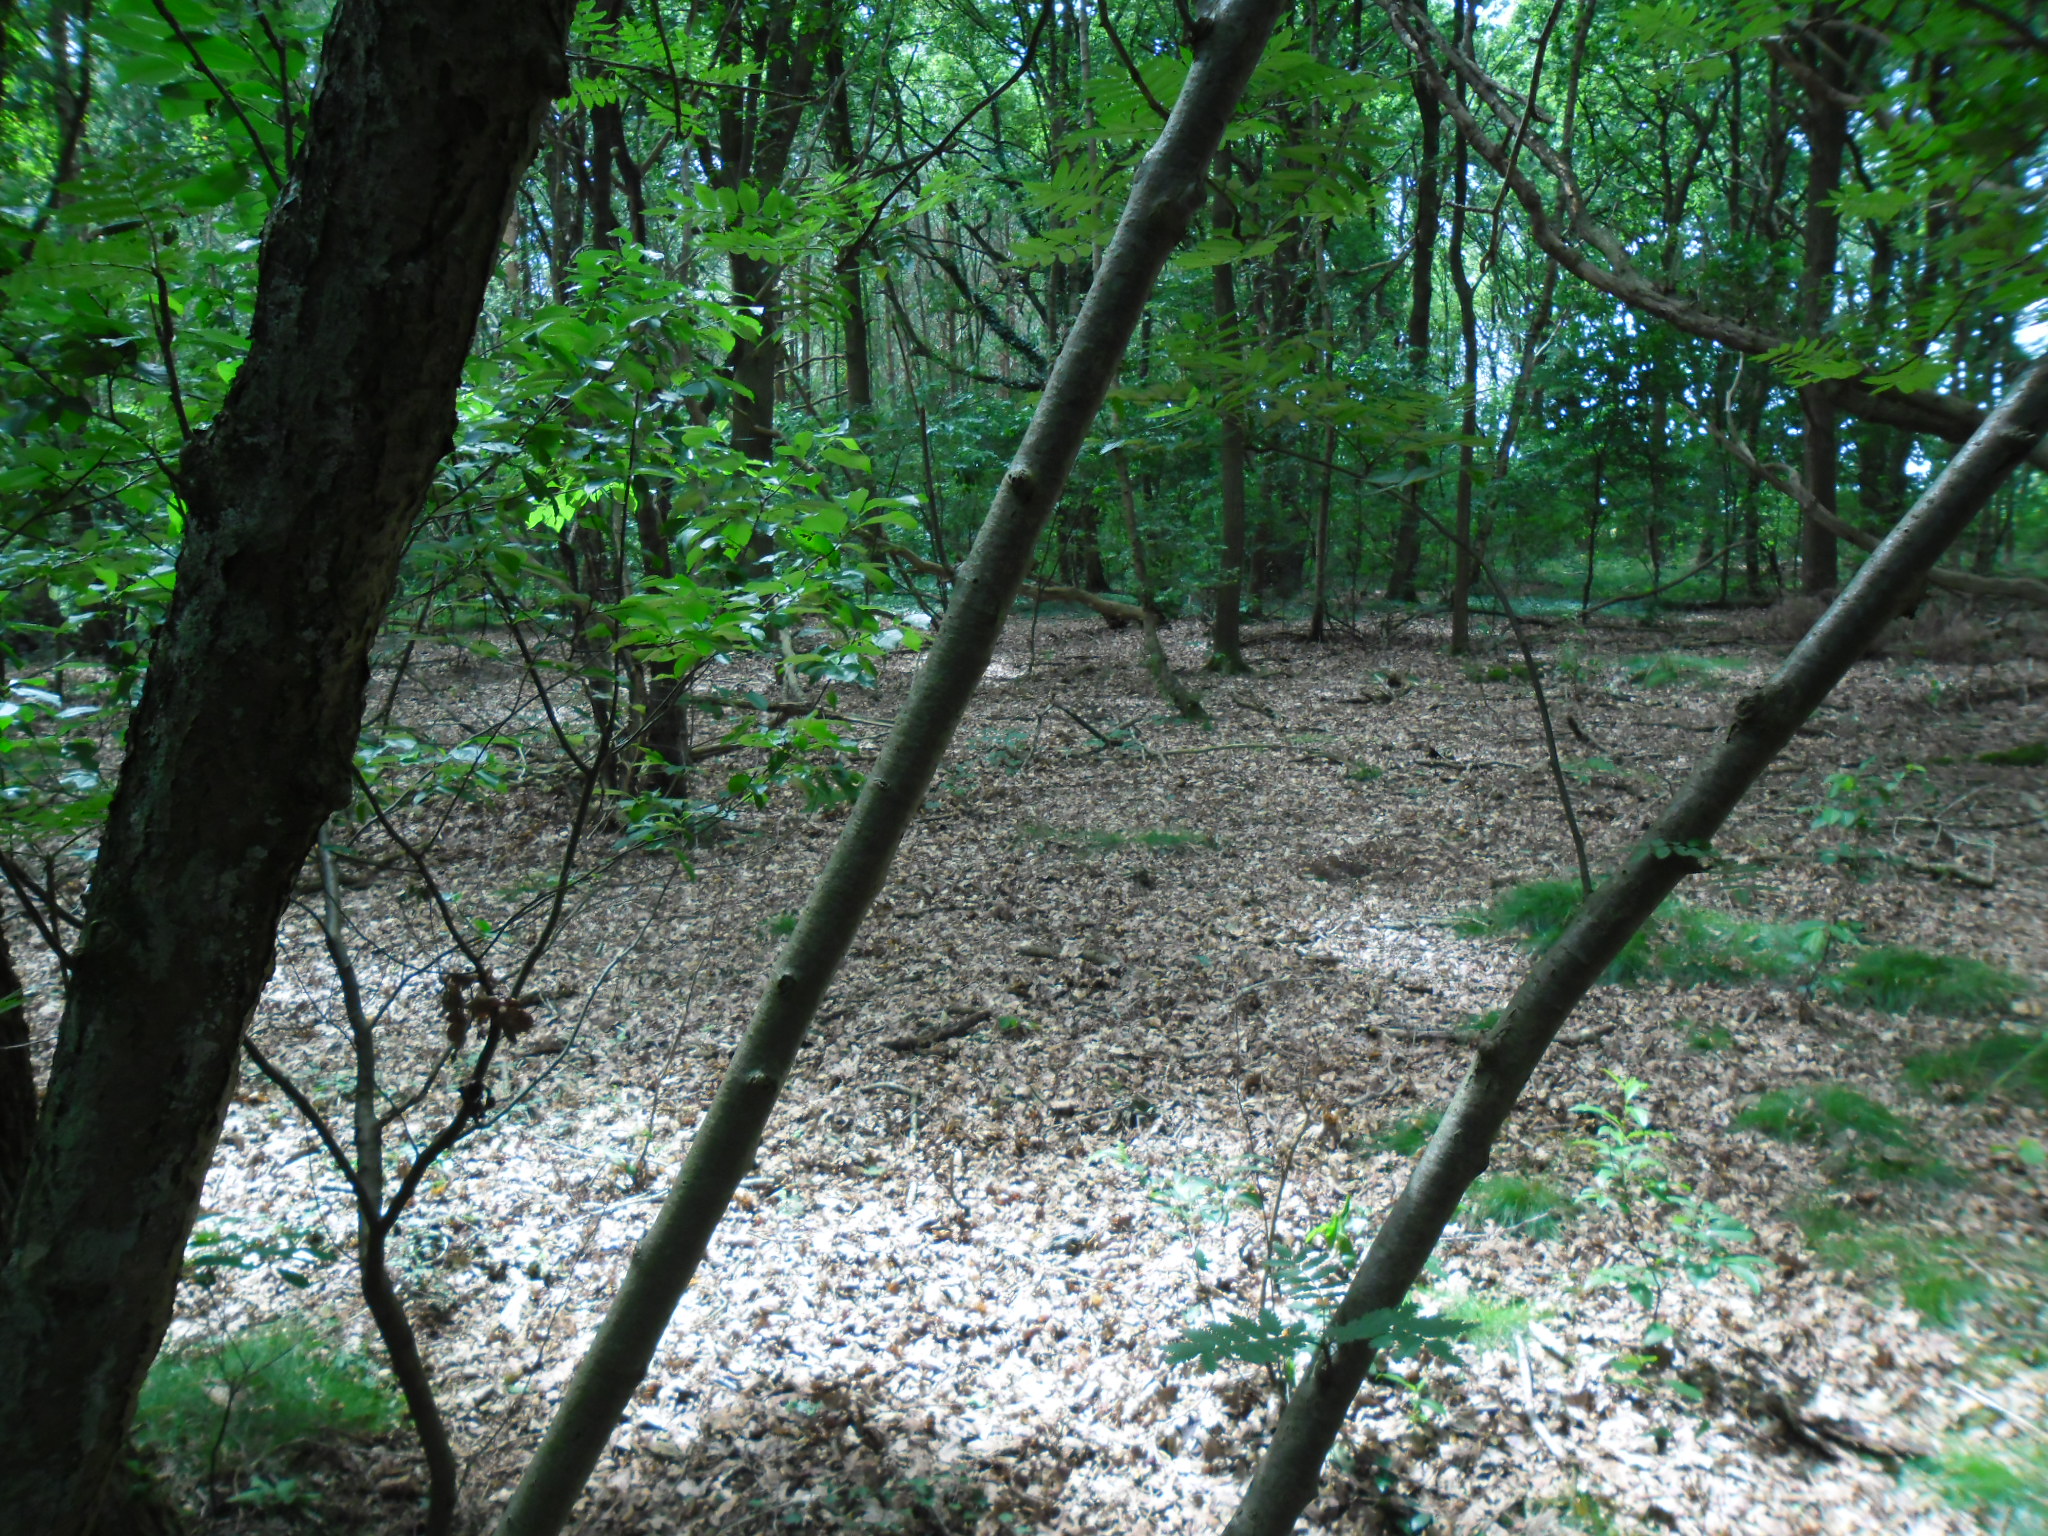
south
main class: Woodland
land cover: Broadleaved woodland
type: mesophytic deciduous forest
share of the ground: > 75 %
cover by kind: broadleaved forest trees 100 %
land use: Amenities, museums, leisure
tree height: > 5 m
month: July
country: NL
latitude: 53.0513
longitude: 6.7032
